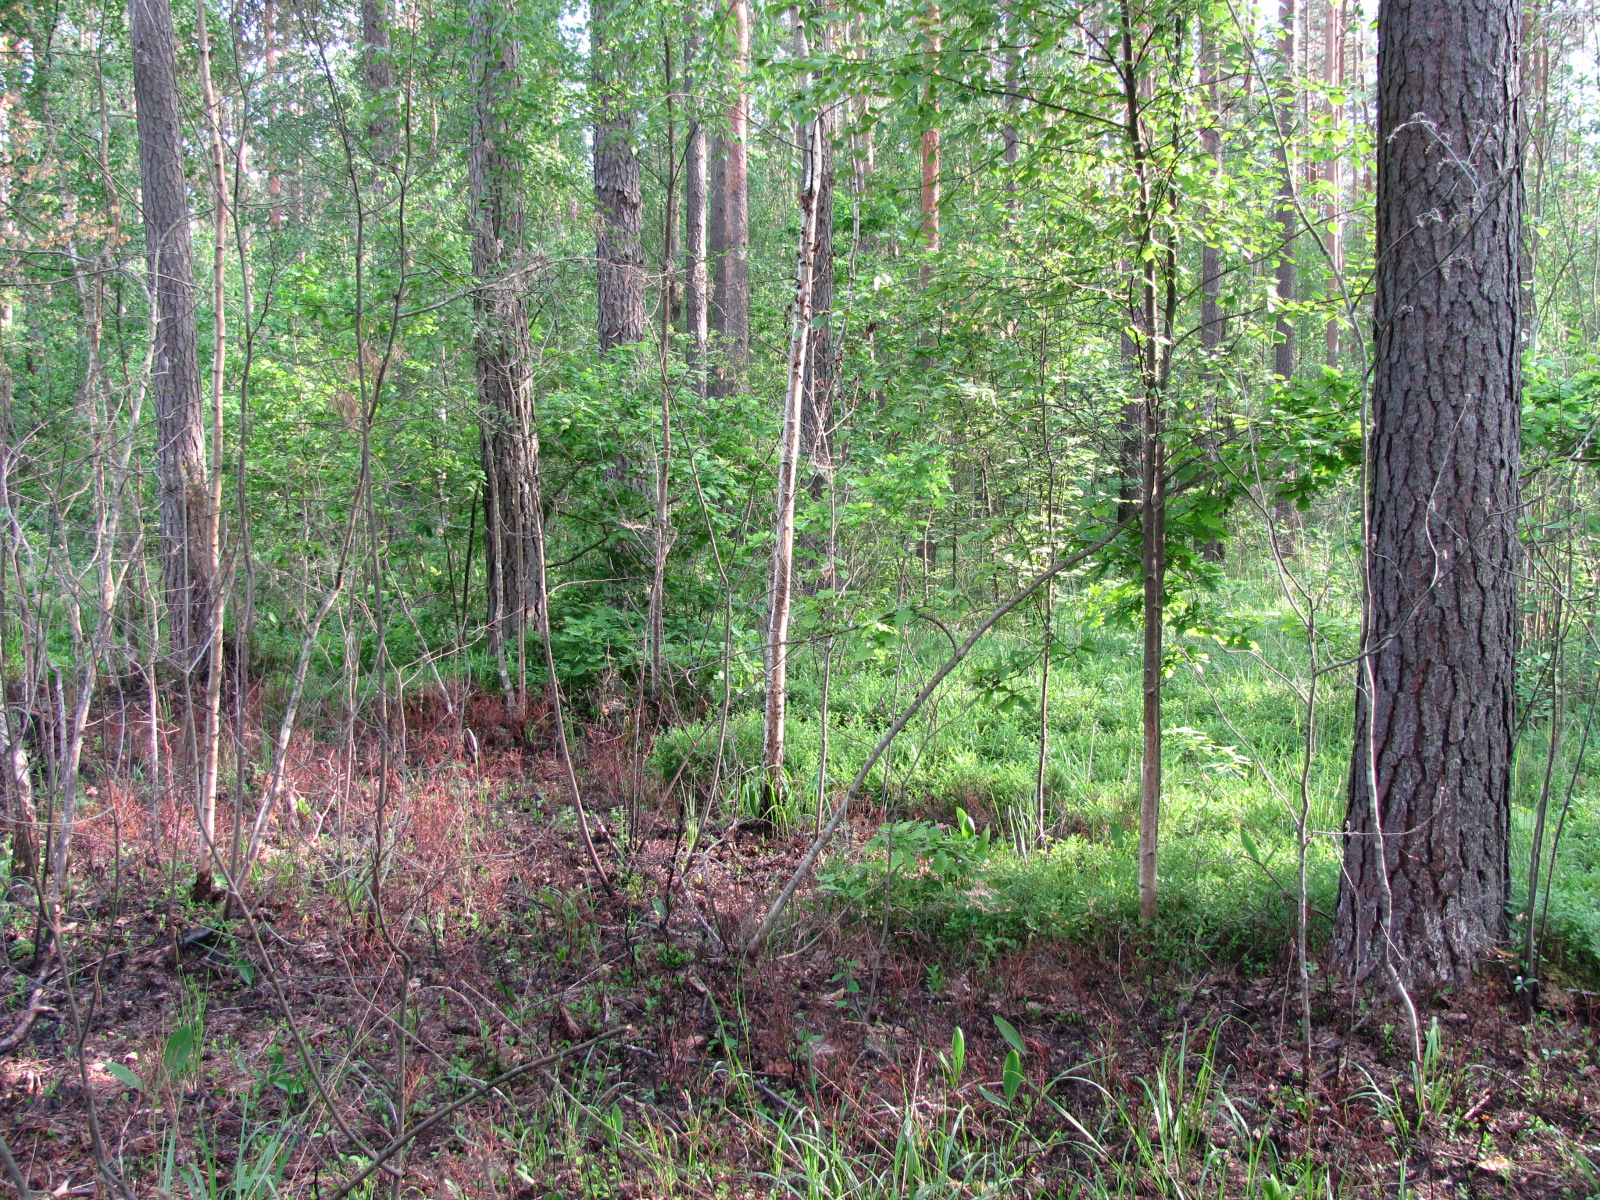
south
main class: Woodland
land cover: Pine dominated mixed woodland
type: hemiboreal forest and nemoral coniferous forest and mixed broadleaved-coniferous forest
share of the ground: > 75 %
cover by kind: coniferous forest trees 60 %, broadleaved forest trees 30 %, herbaceous plants 10 %
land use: Forestry
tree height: > 5 m
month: June
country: LV
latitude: 56.9323
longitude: 24.3376
